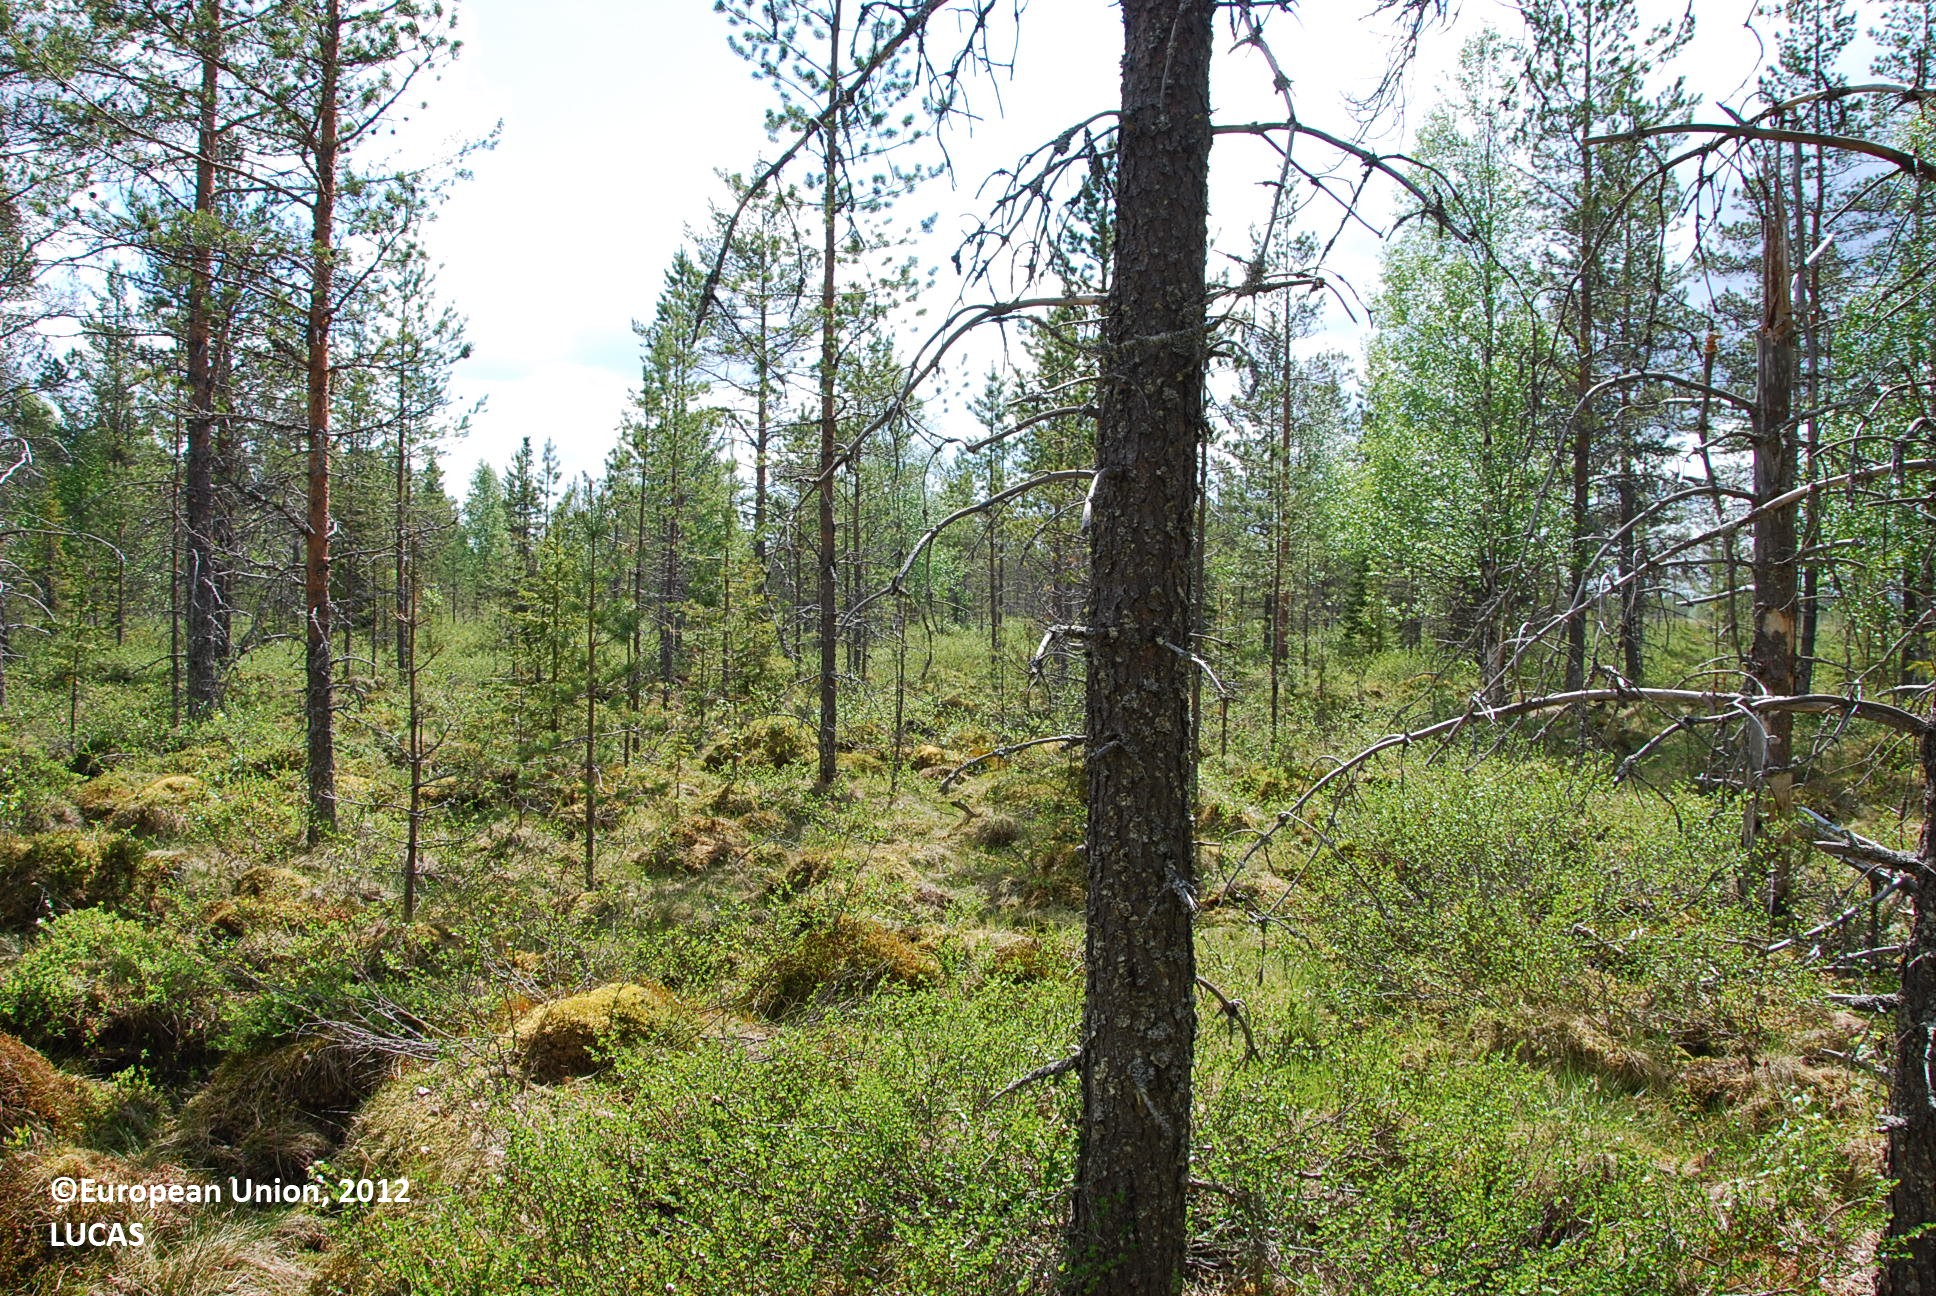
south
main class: Woodland
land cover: Pine dominated mixed woodland
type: boreal forest
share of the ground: 50 - 75 %
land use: Forestry
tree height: > 5 m
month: June
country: FI
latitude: 66.0278
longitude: 27.6164
